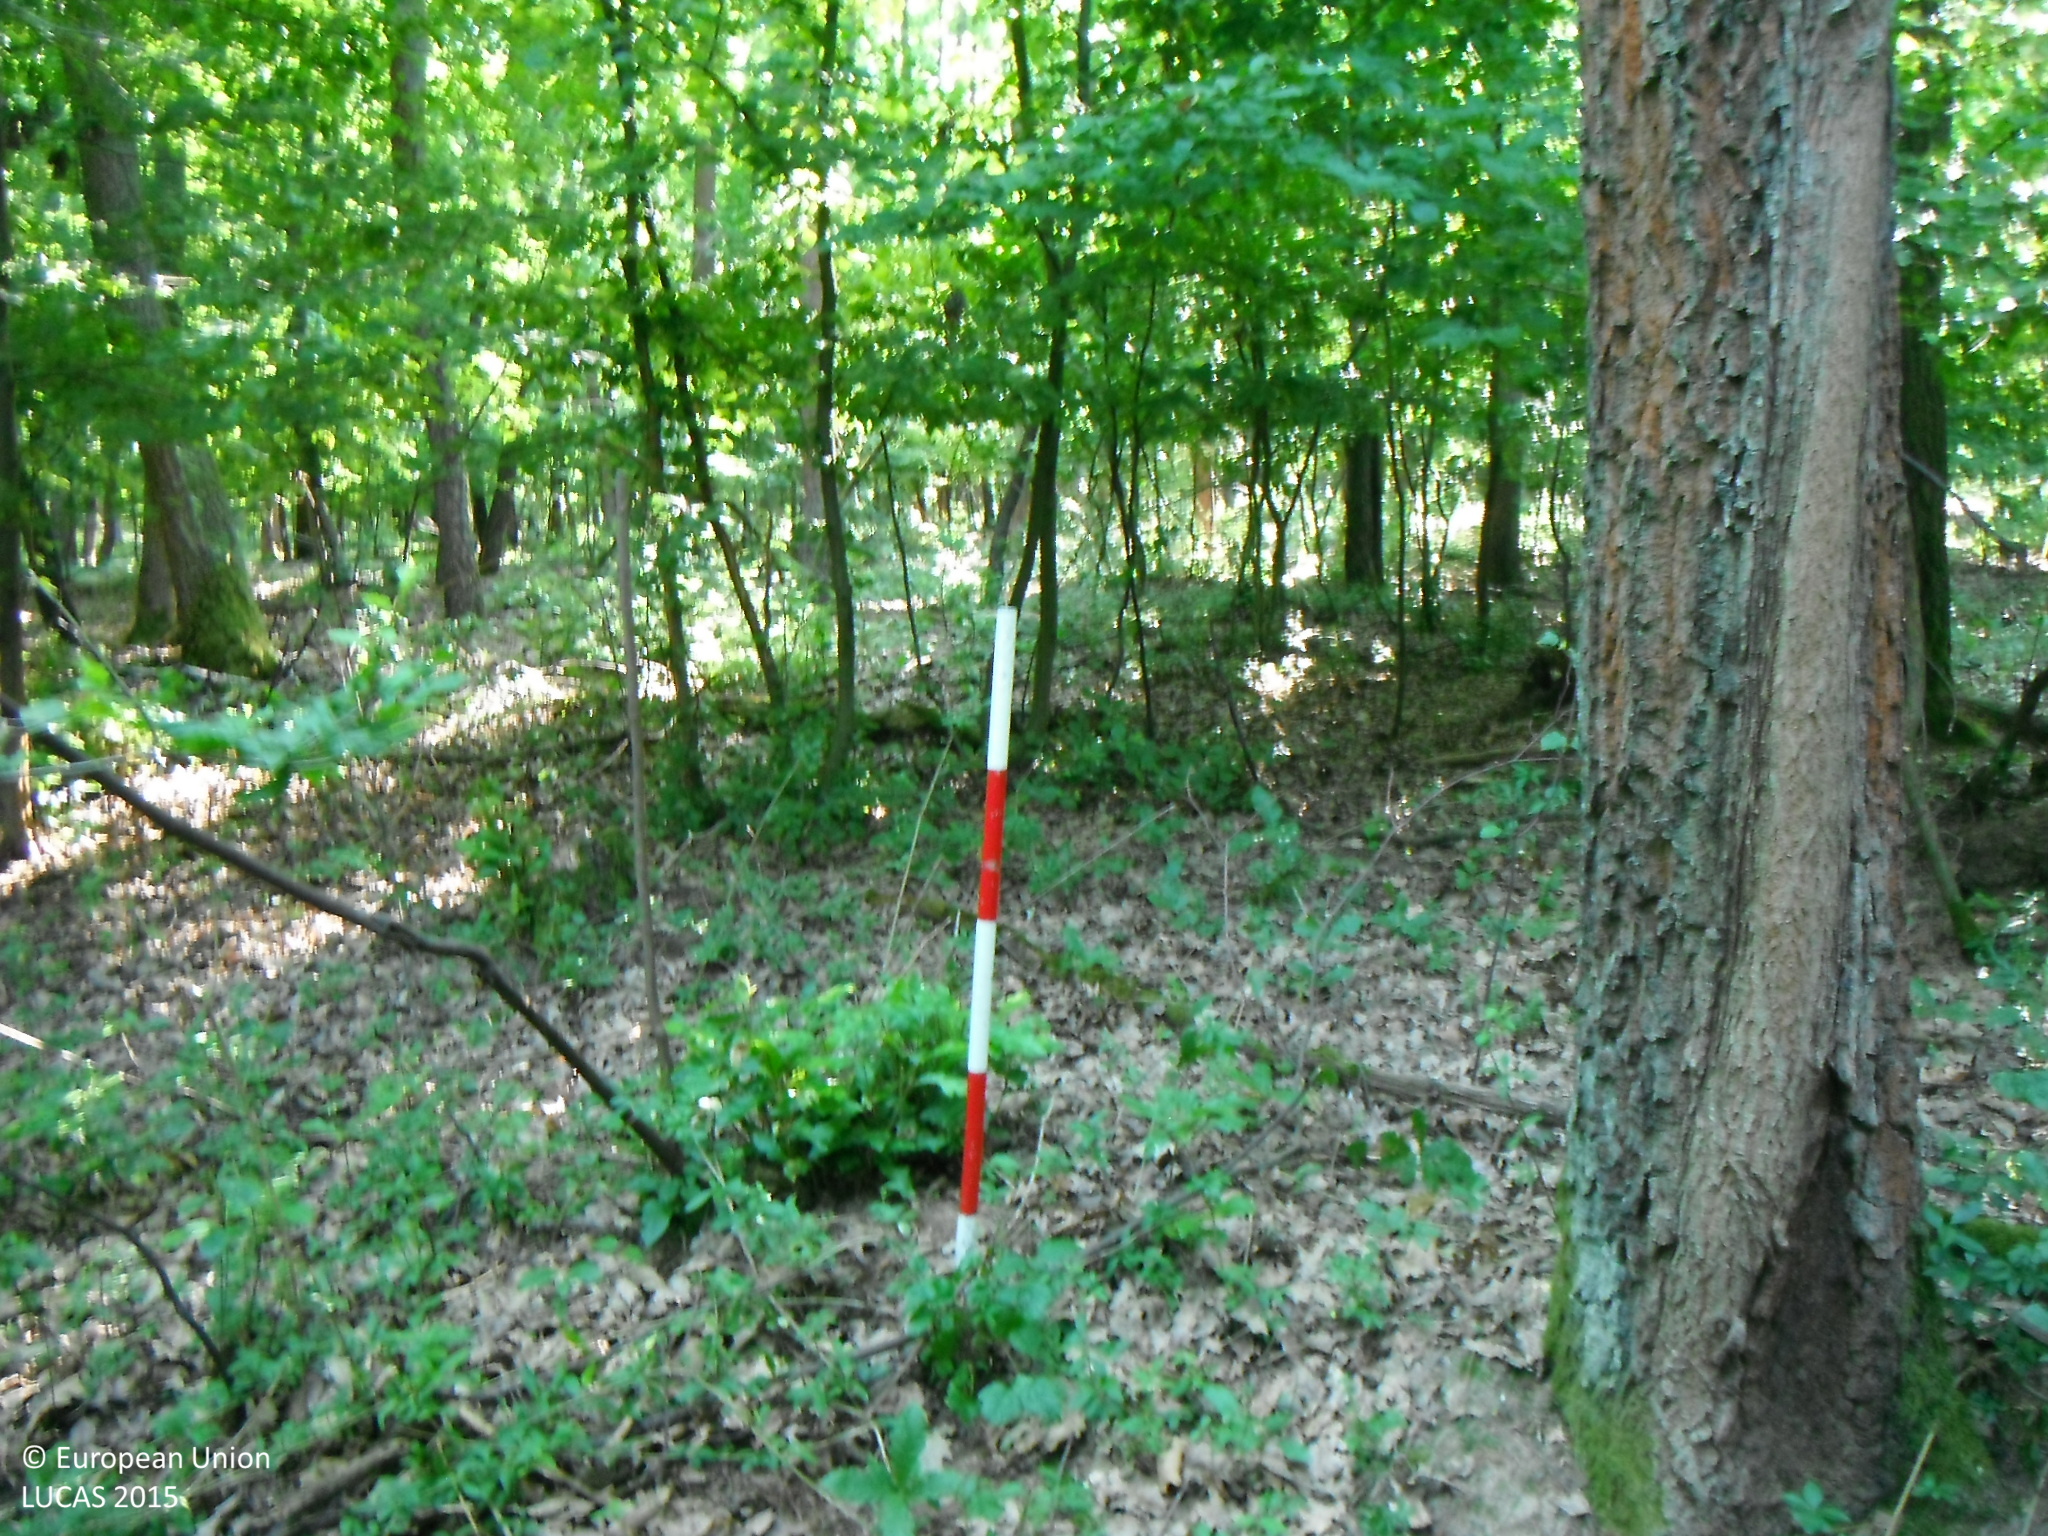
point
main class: Woodland
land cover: Broadleaved woodland
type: acidophilous oak and oak-birch forest
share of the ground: > 75 %
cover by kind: broadleaved forest trees 100 %
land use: Forestry
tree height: > 5 m
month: June
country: SK
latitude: 48.3825
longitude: 19.8168
